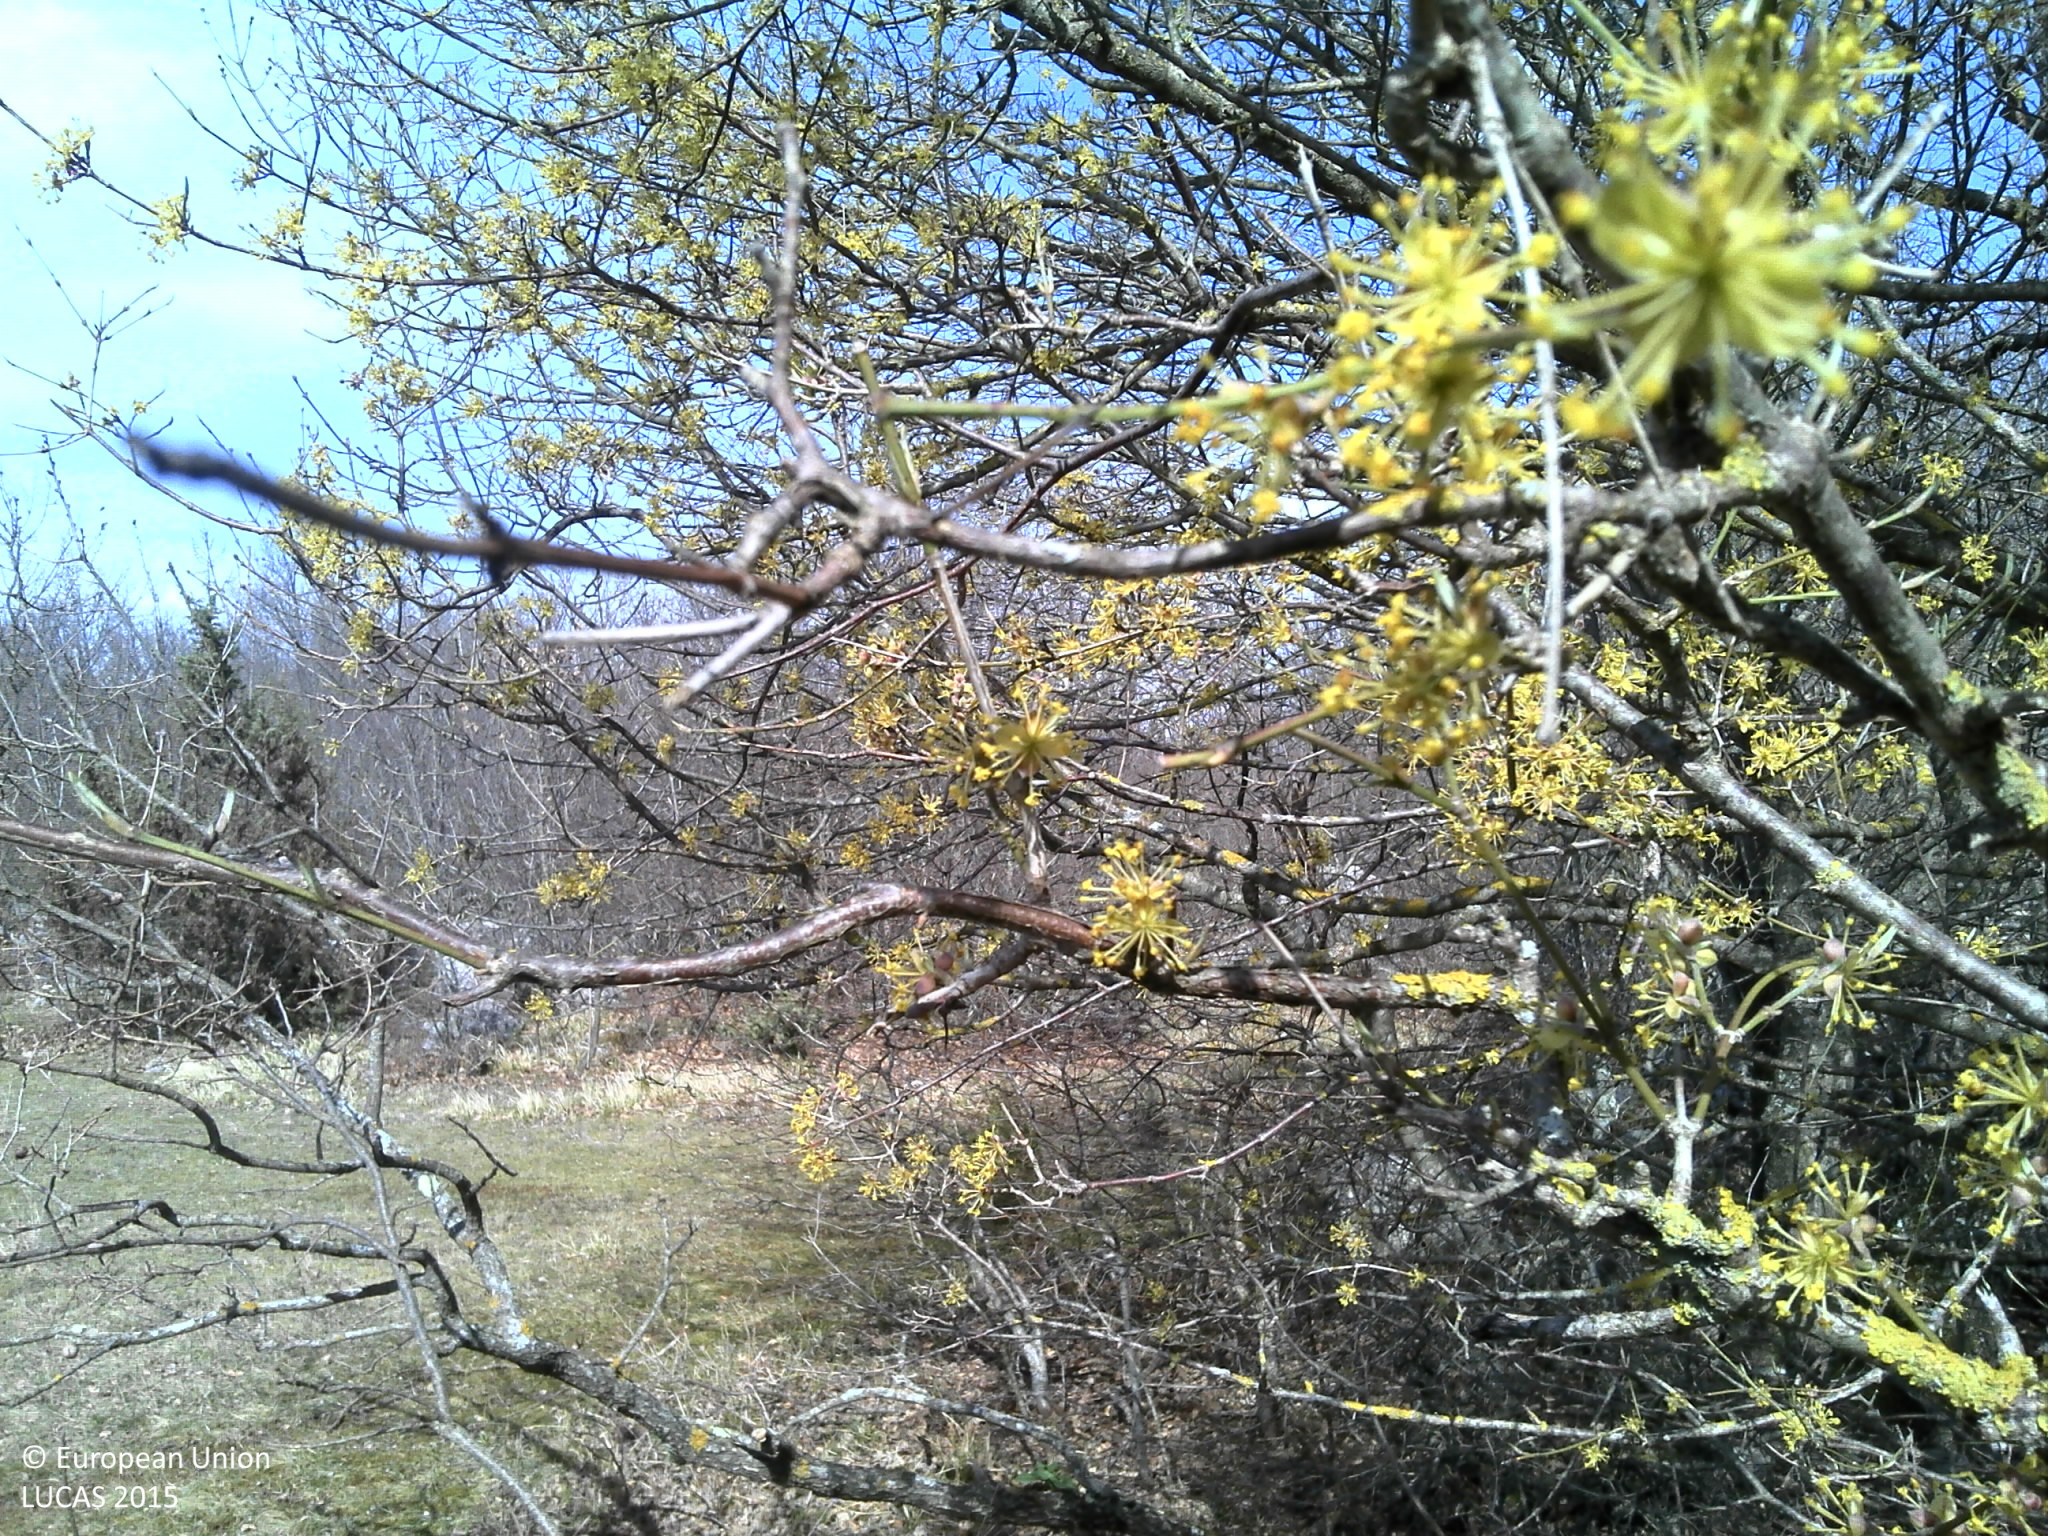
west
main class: Woodland
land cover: Broadleaved woodland
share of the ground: 25 - 50 %
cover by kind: broadleaved forest trees 40 %, herbaceous plants 35 %, lichens and mosses 10 %, unconsolidated bare surface 10 %, consolidated bare surface 5 %
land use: Agriculture (excluding fallow land and kitchen gardens)
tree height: > 5 m
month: March
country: HR
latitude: 44.0397
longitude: 15.8698
